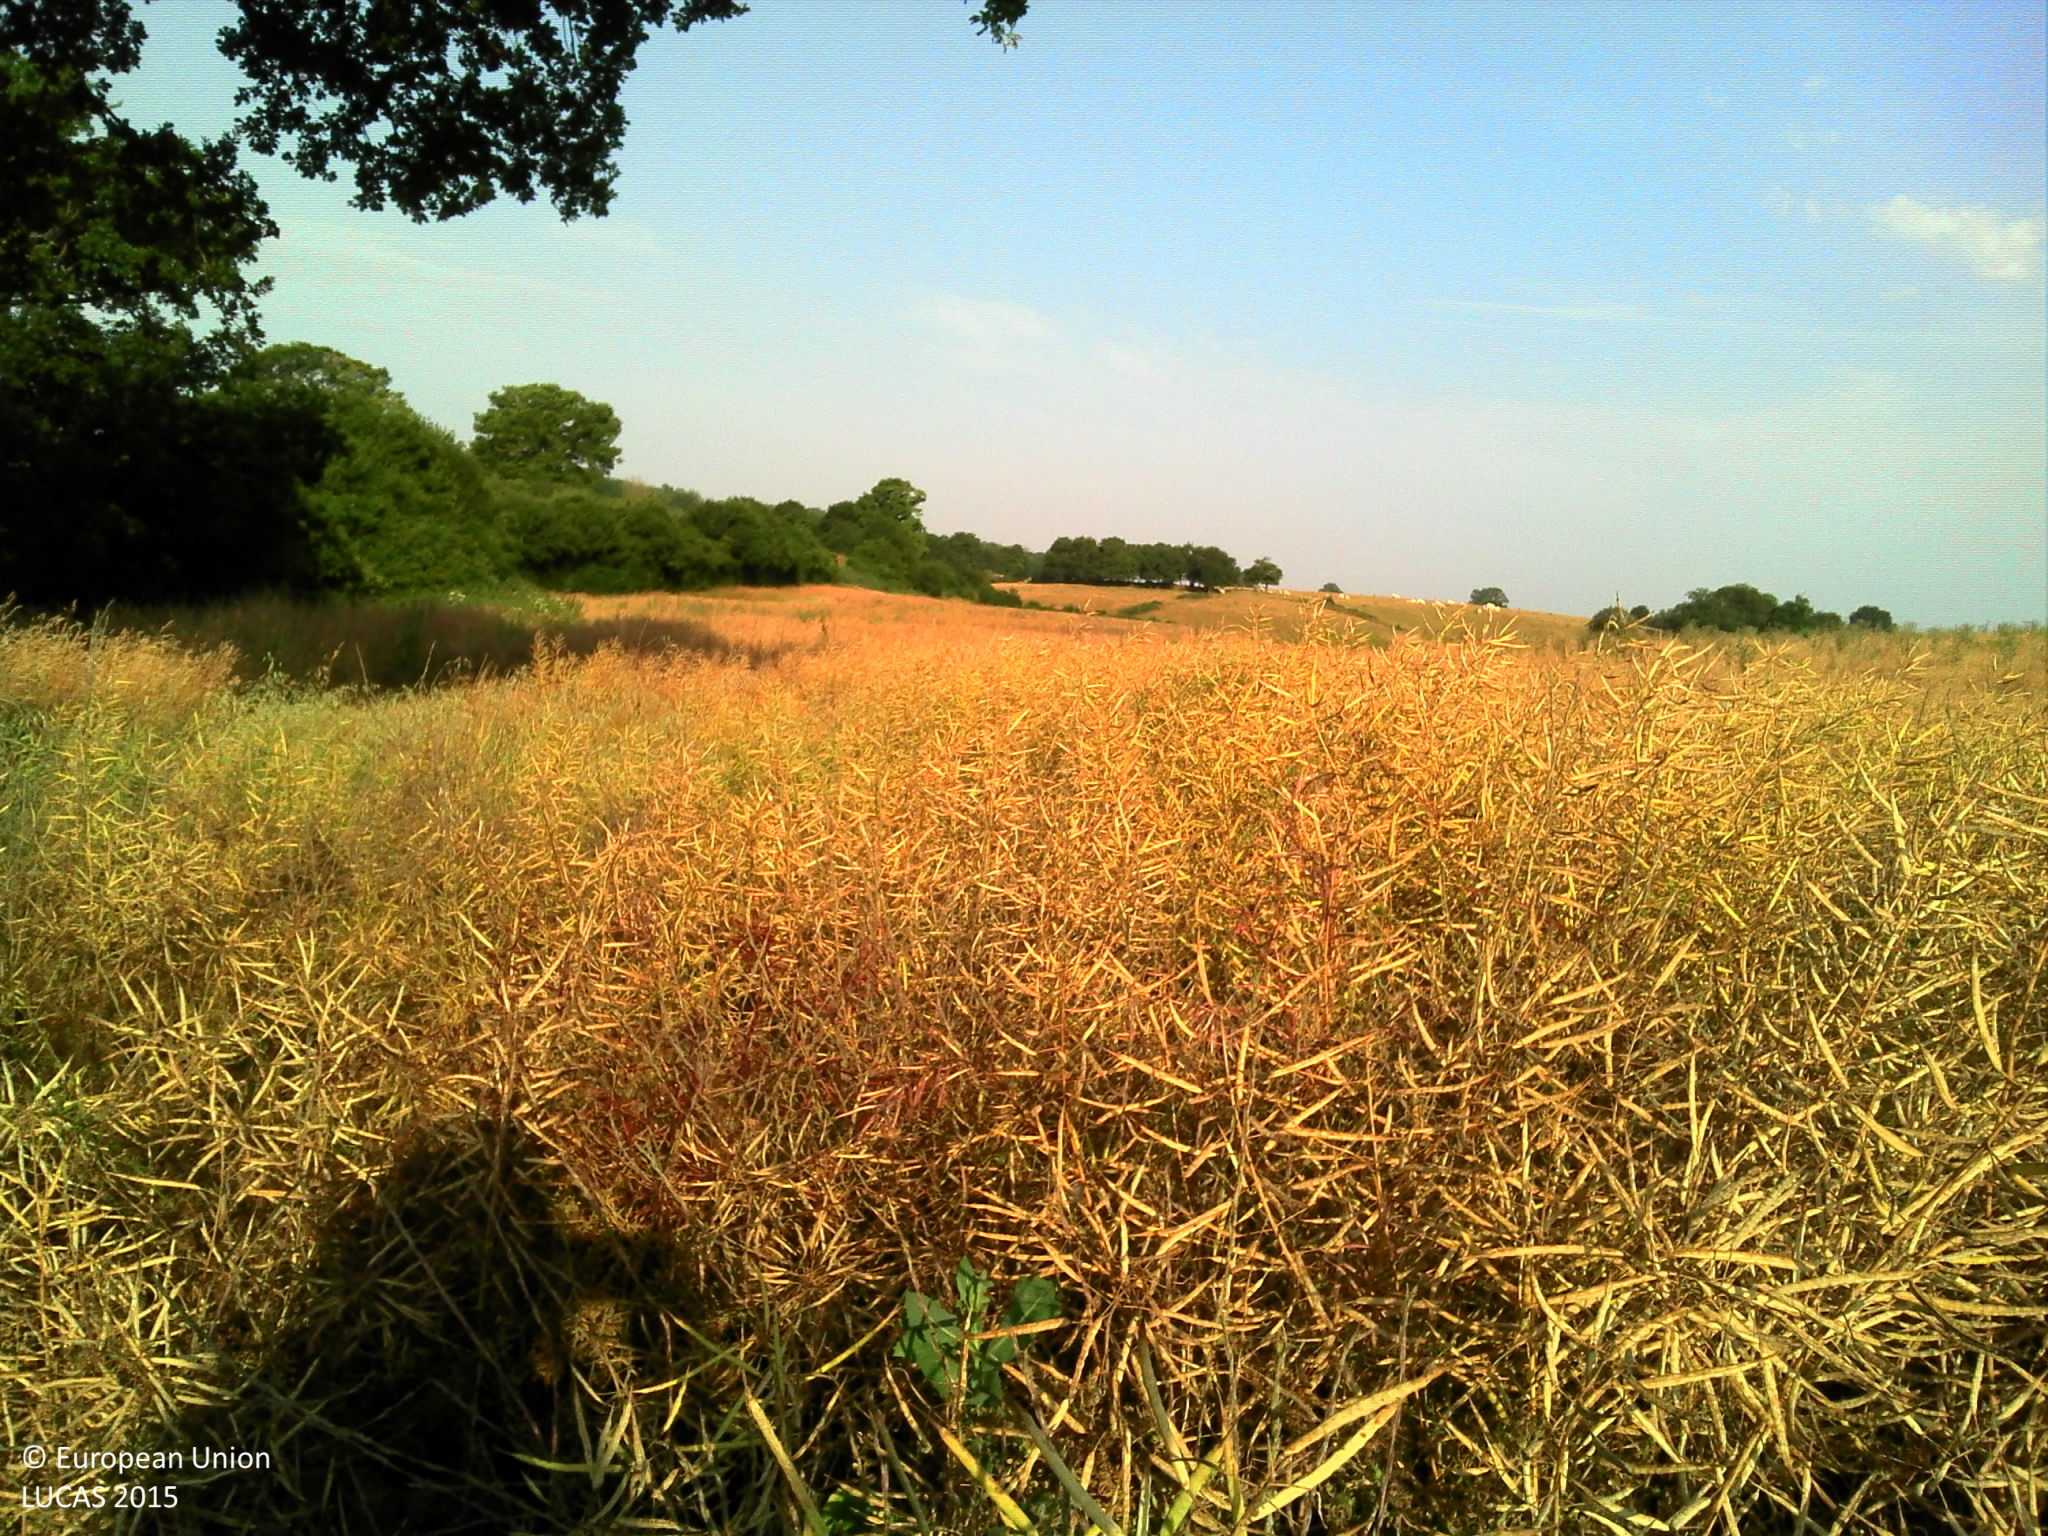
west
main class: Cropland
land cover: Rape and turnip rape
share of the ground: > 75 %
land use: Agriculture (excluding fallow land and kitchen gardens)
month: July
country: FR
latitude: 47.0633
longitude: 3.6119
